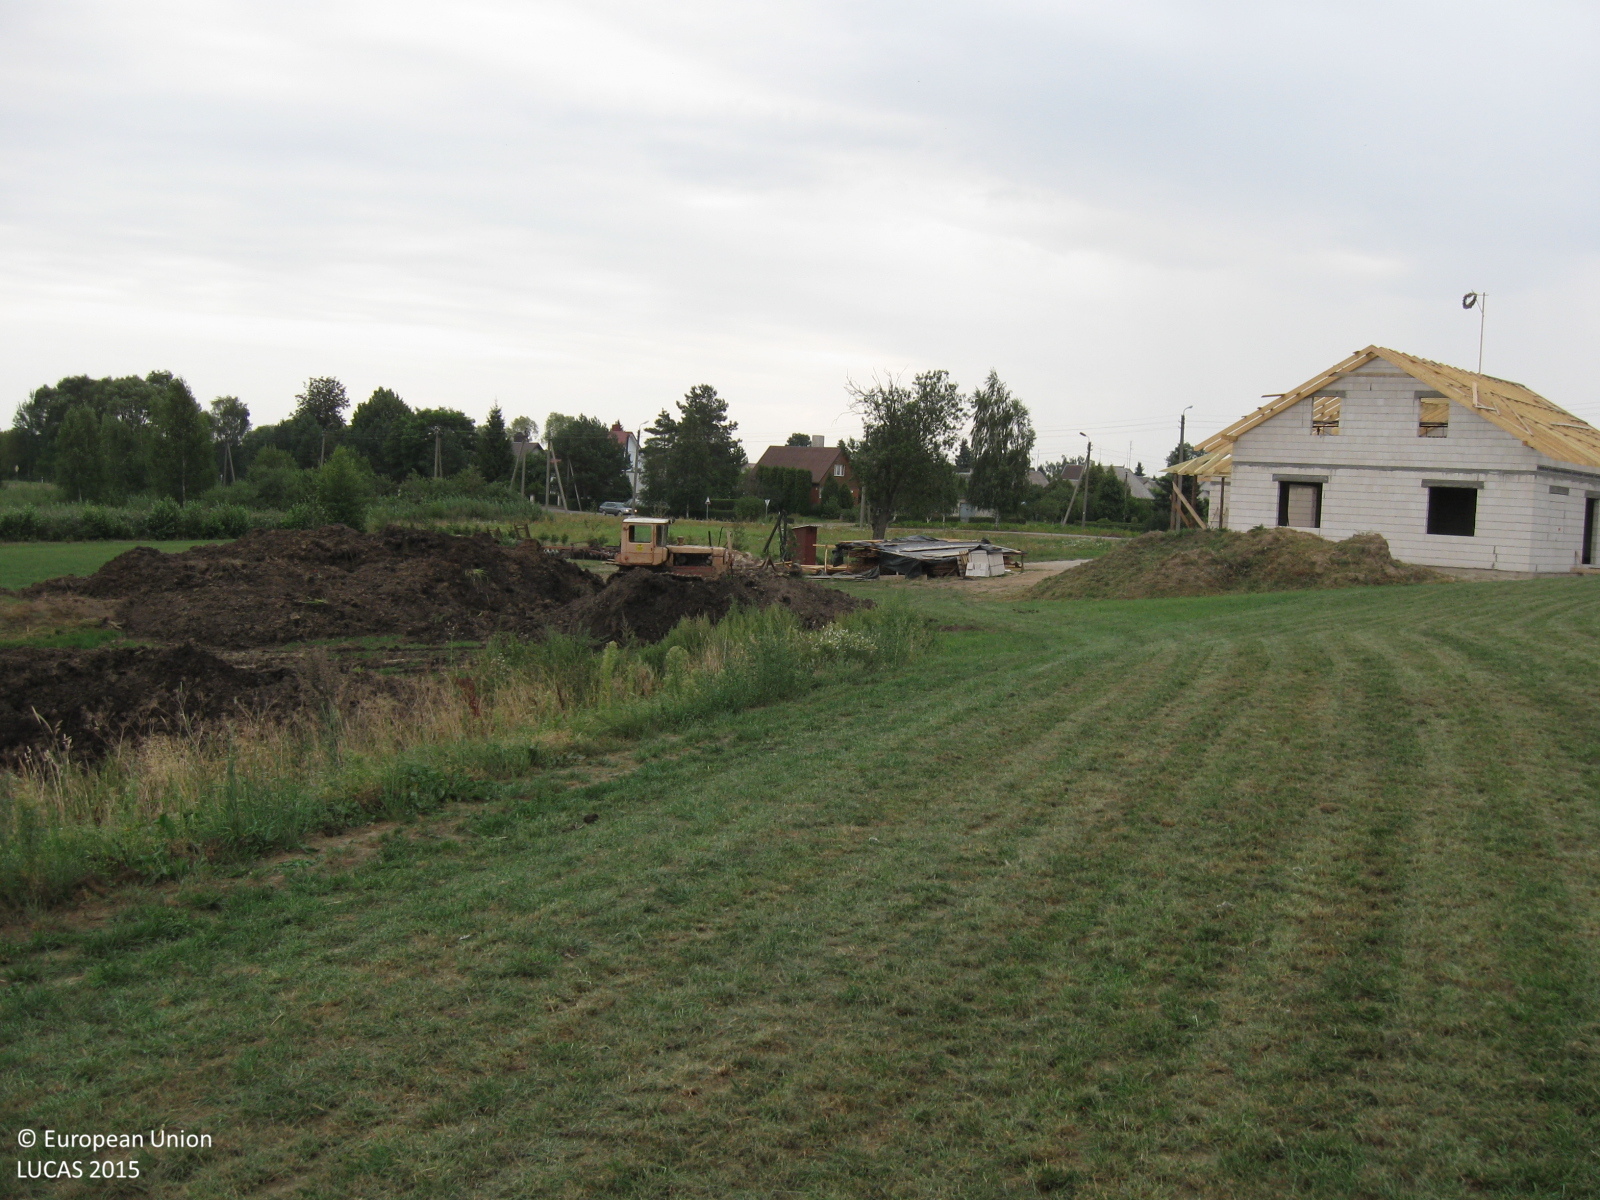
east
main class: Grassland
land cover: Grassland without tree/shrub cover
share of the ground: > 75 %
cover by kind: herbaceous plants 100 %
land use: Agriculture (excluding fallow land and kitchen gardens)
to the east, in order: Grassland without tree/shrub cover; Spontaneously vegetated surfaces; Artificial constructions in urban areas; Grassland without tree/shrub cover; Artificial constructions in urban areas
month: August
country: LT
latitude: 55.3806
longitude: 22.9641
